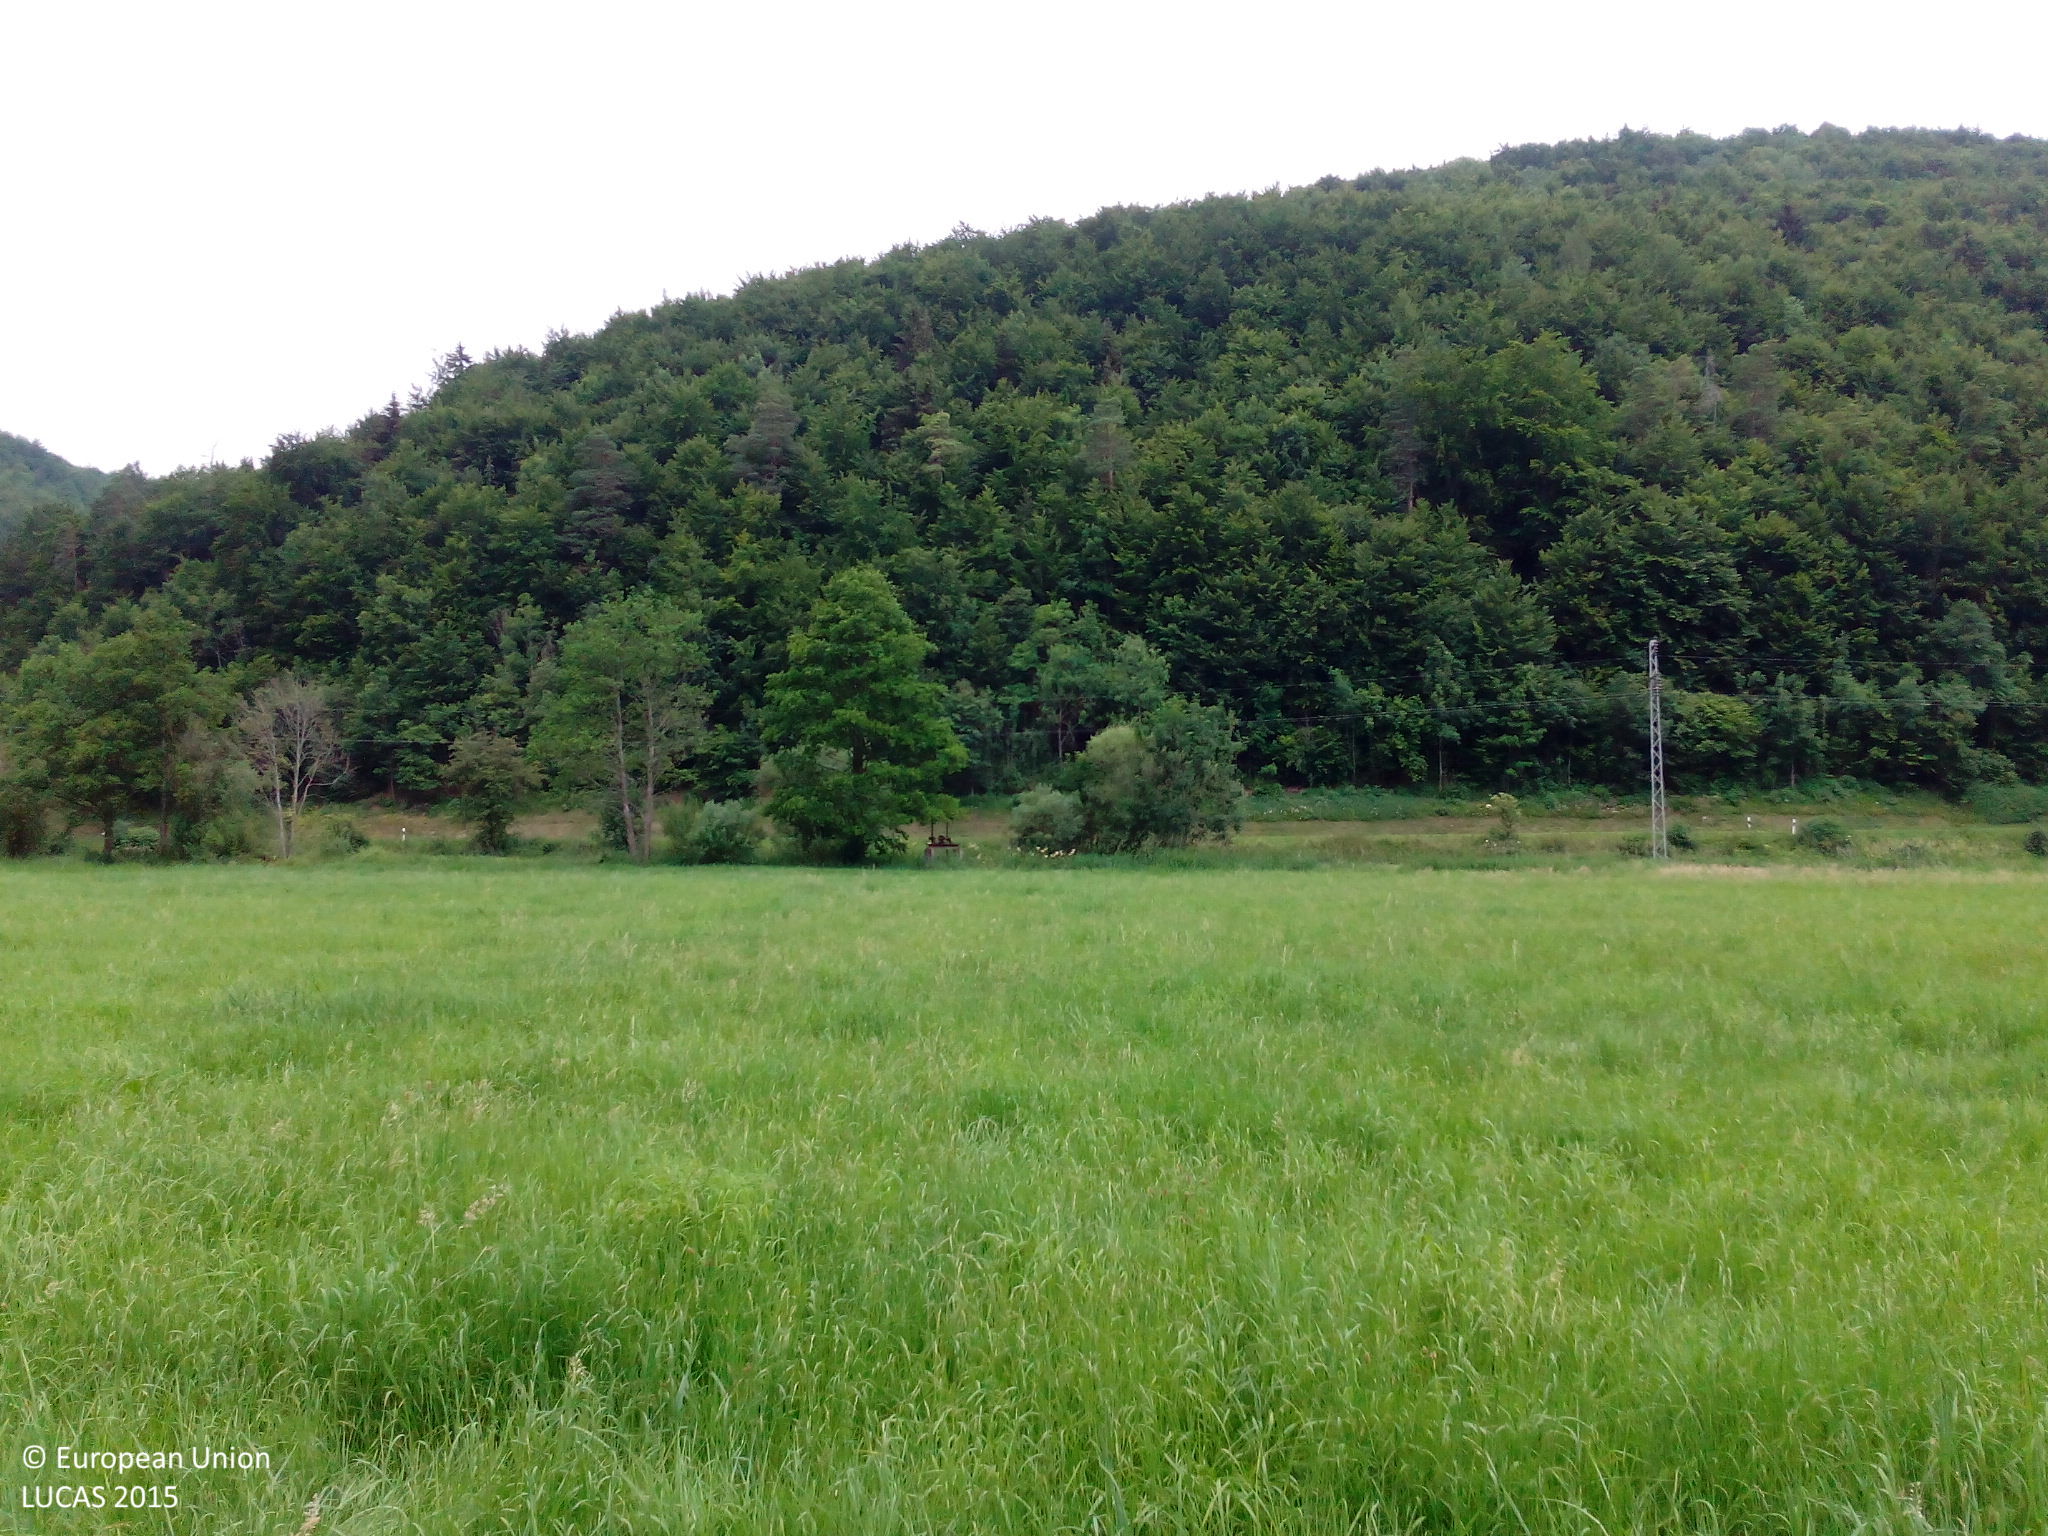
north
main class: Grassland
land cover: Grassland without tree/shrub cover
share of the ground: > 75 %
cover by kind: herbaceous plants 100 %
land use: Agriculture (excluding fallow land and kitchen gardens)
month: July
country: DE
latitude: 48.3670
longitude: 9.6897
